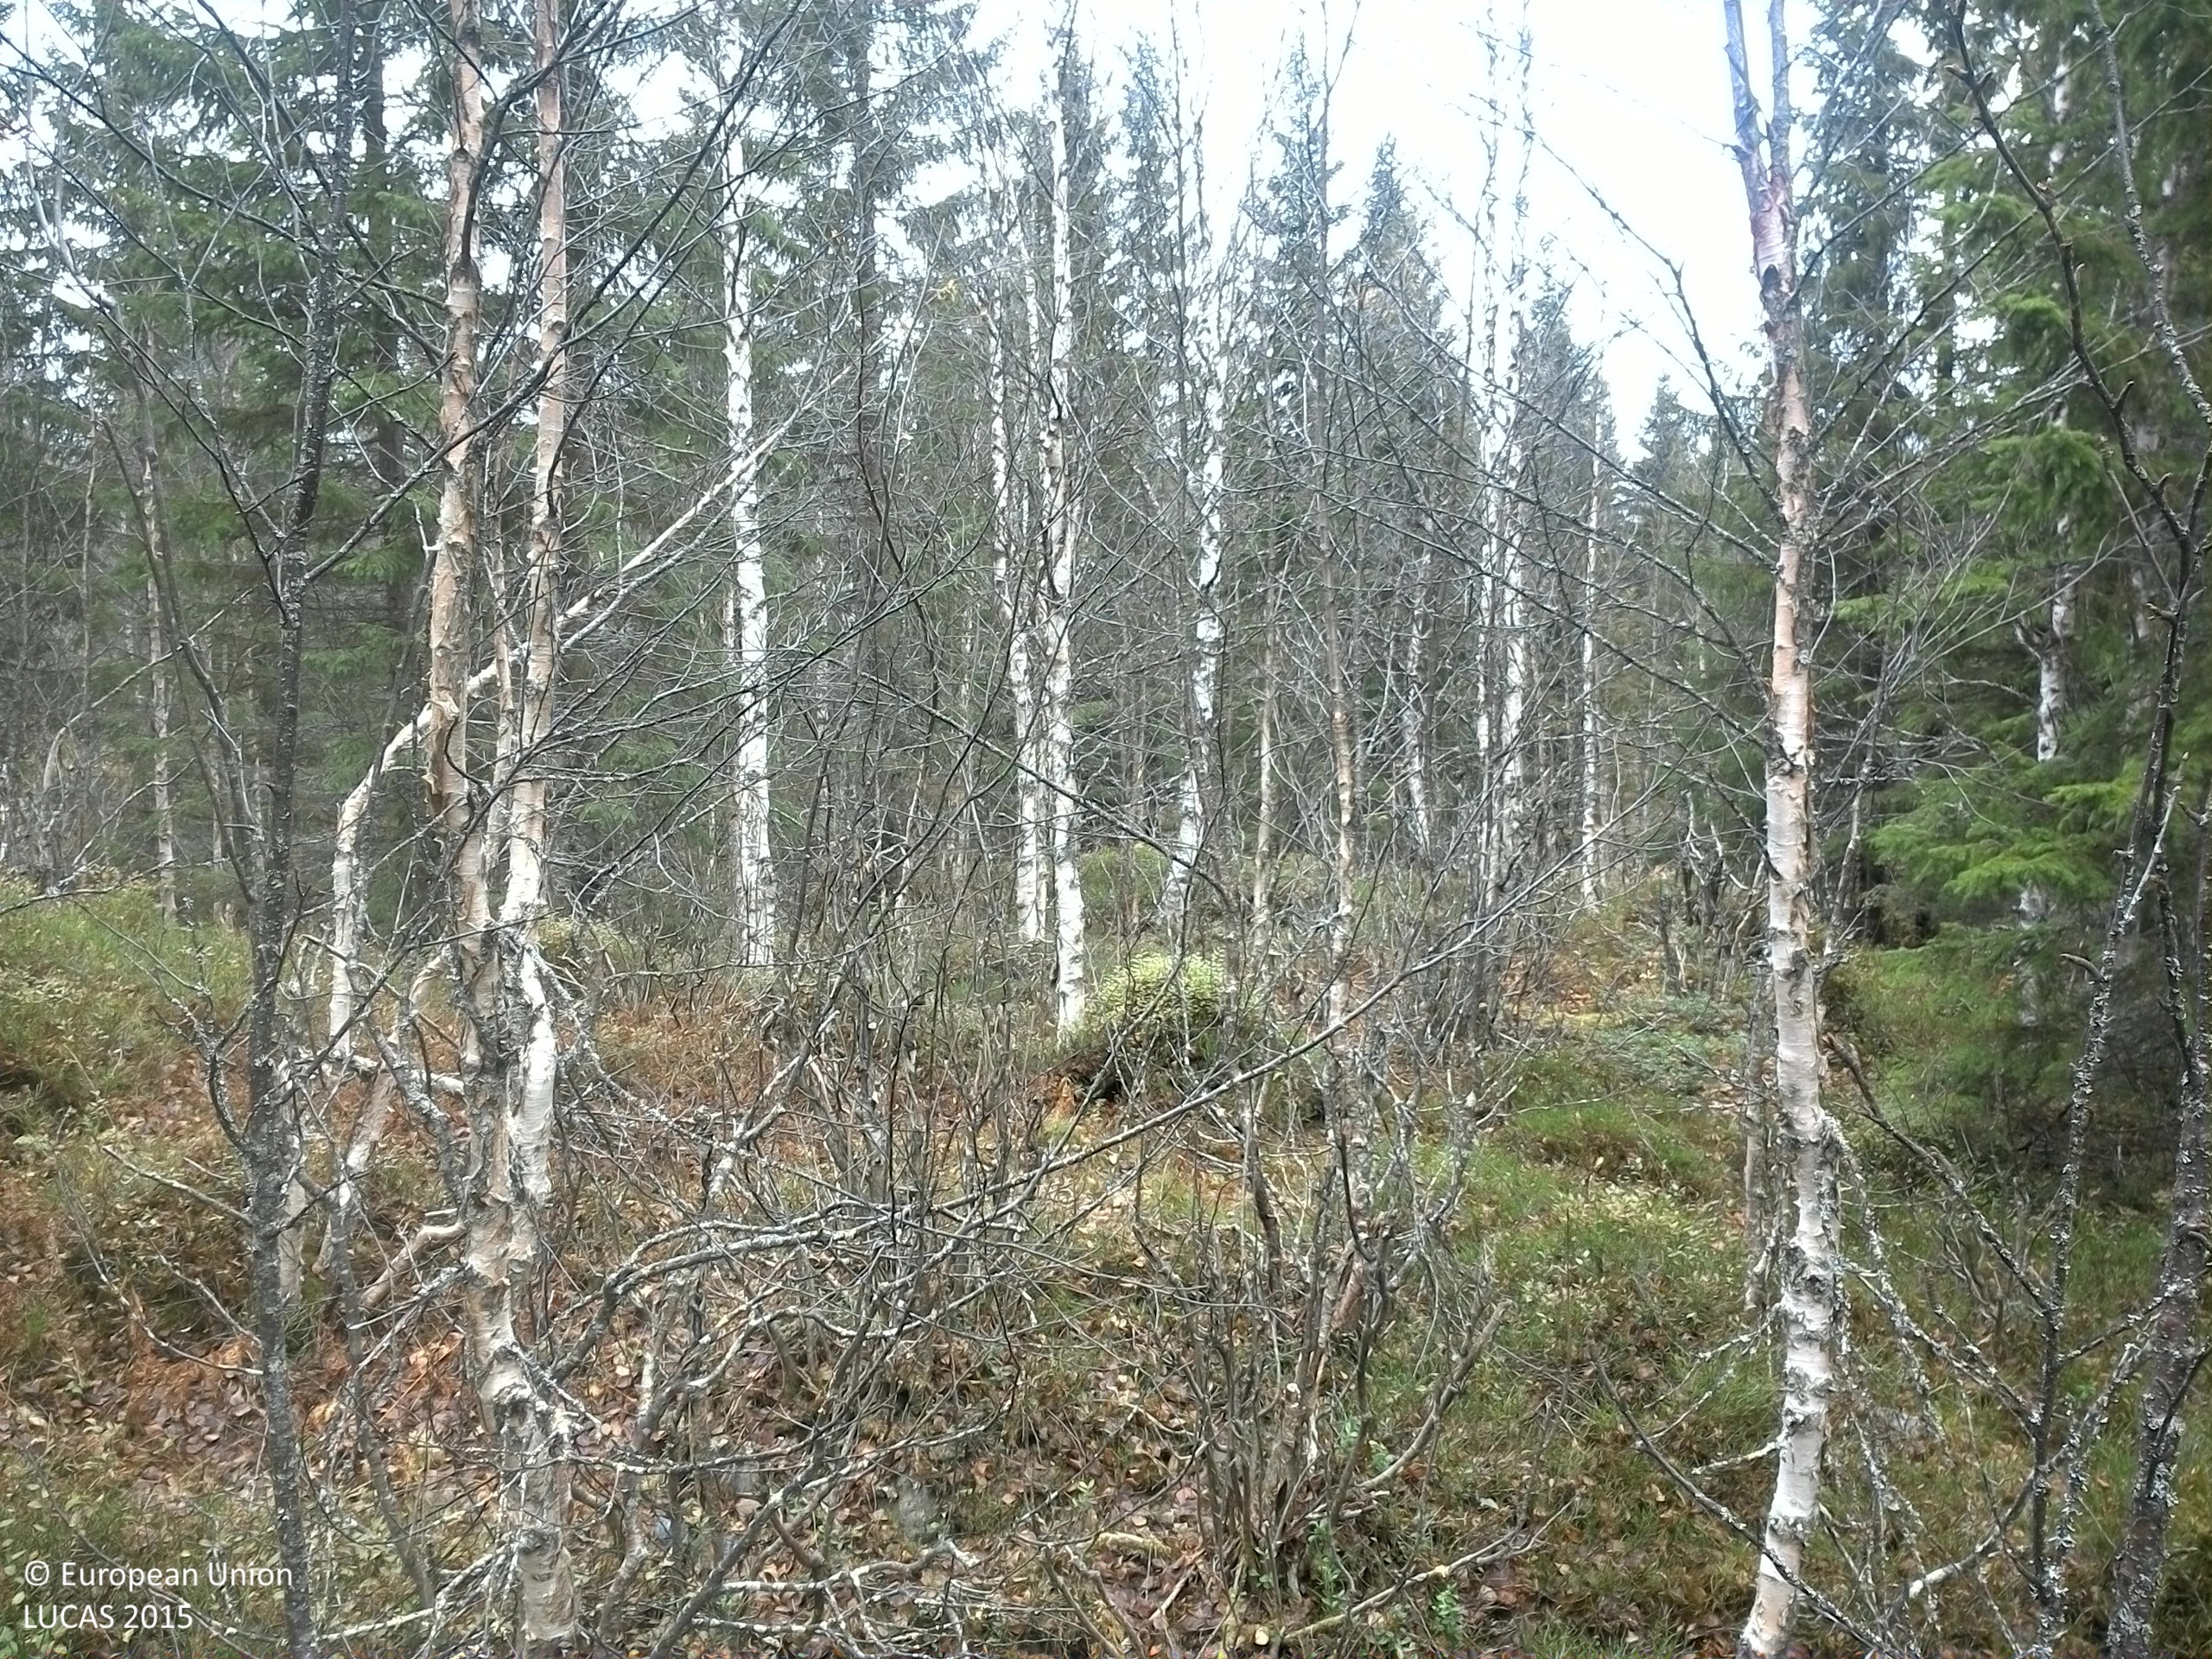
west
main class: Woodland
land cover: Spruce dominated mixed woodland
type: boreal forest
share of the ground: 50 - 75 %
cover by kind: coniferous forest trees 30 %, broadleaved forest trees 25 %, shrubs 20 %, herbaceous plants 15 %, lichens and mosses 10 %
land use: Forestry
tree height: > 5 m
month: October
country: SE
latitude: 64.3931
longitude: 15.5076
